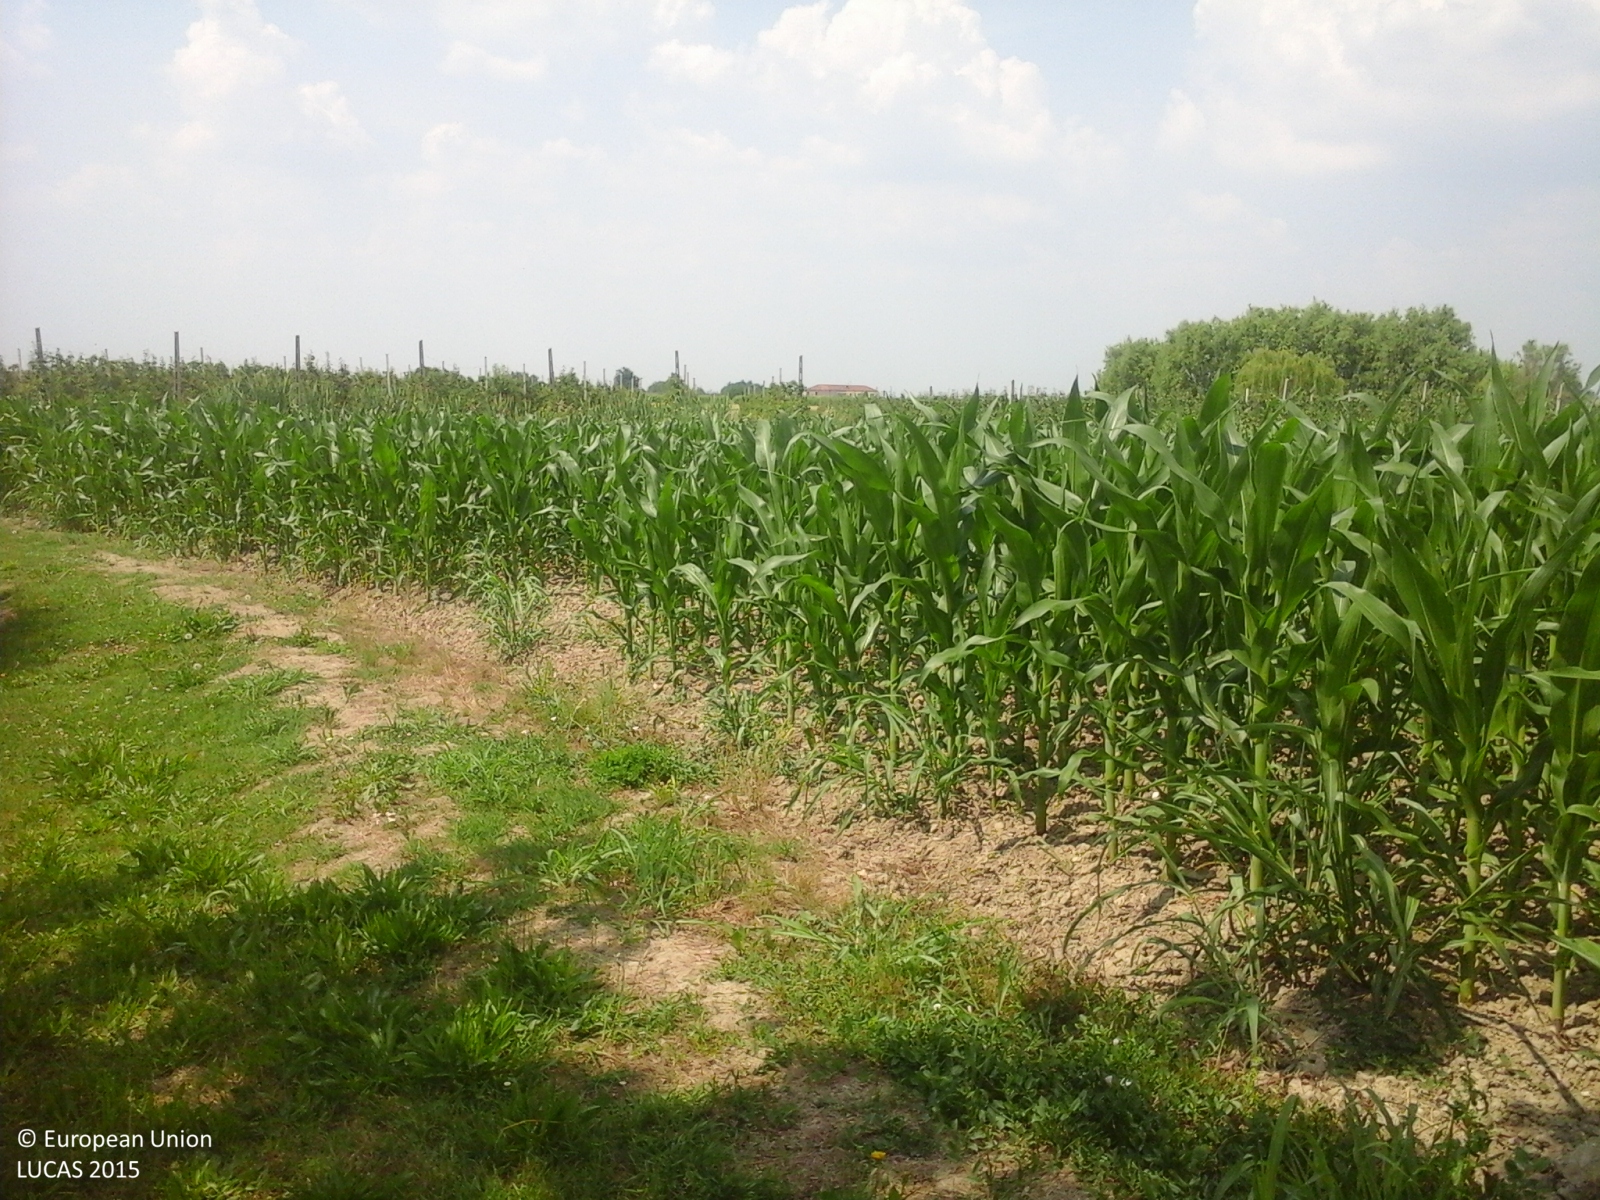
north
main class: Cropland
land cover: Durum wheat
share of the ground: > 75 %
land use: Agriculture (excluding fallow land and kitchen gardens)
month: June
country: IT
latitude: 44.7330
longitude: 11.7265
